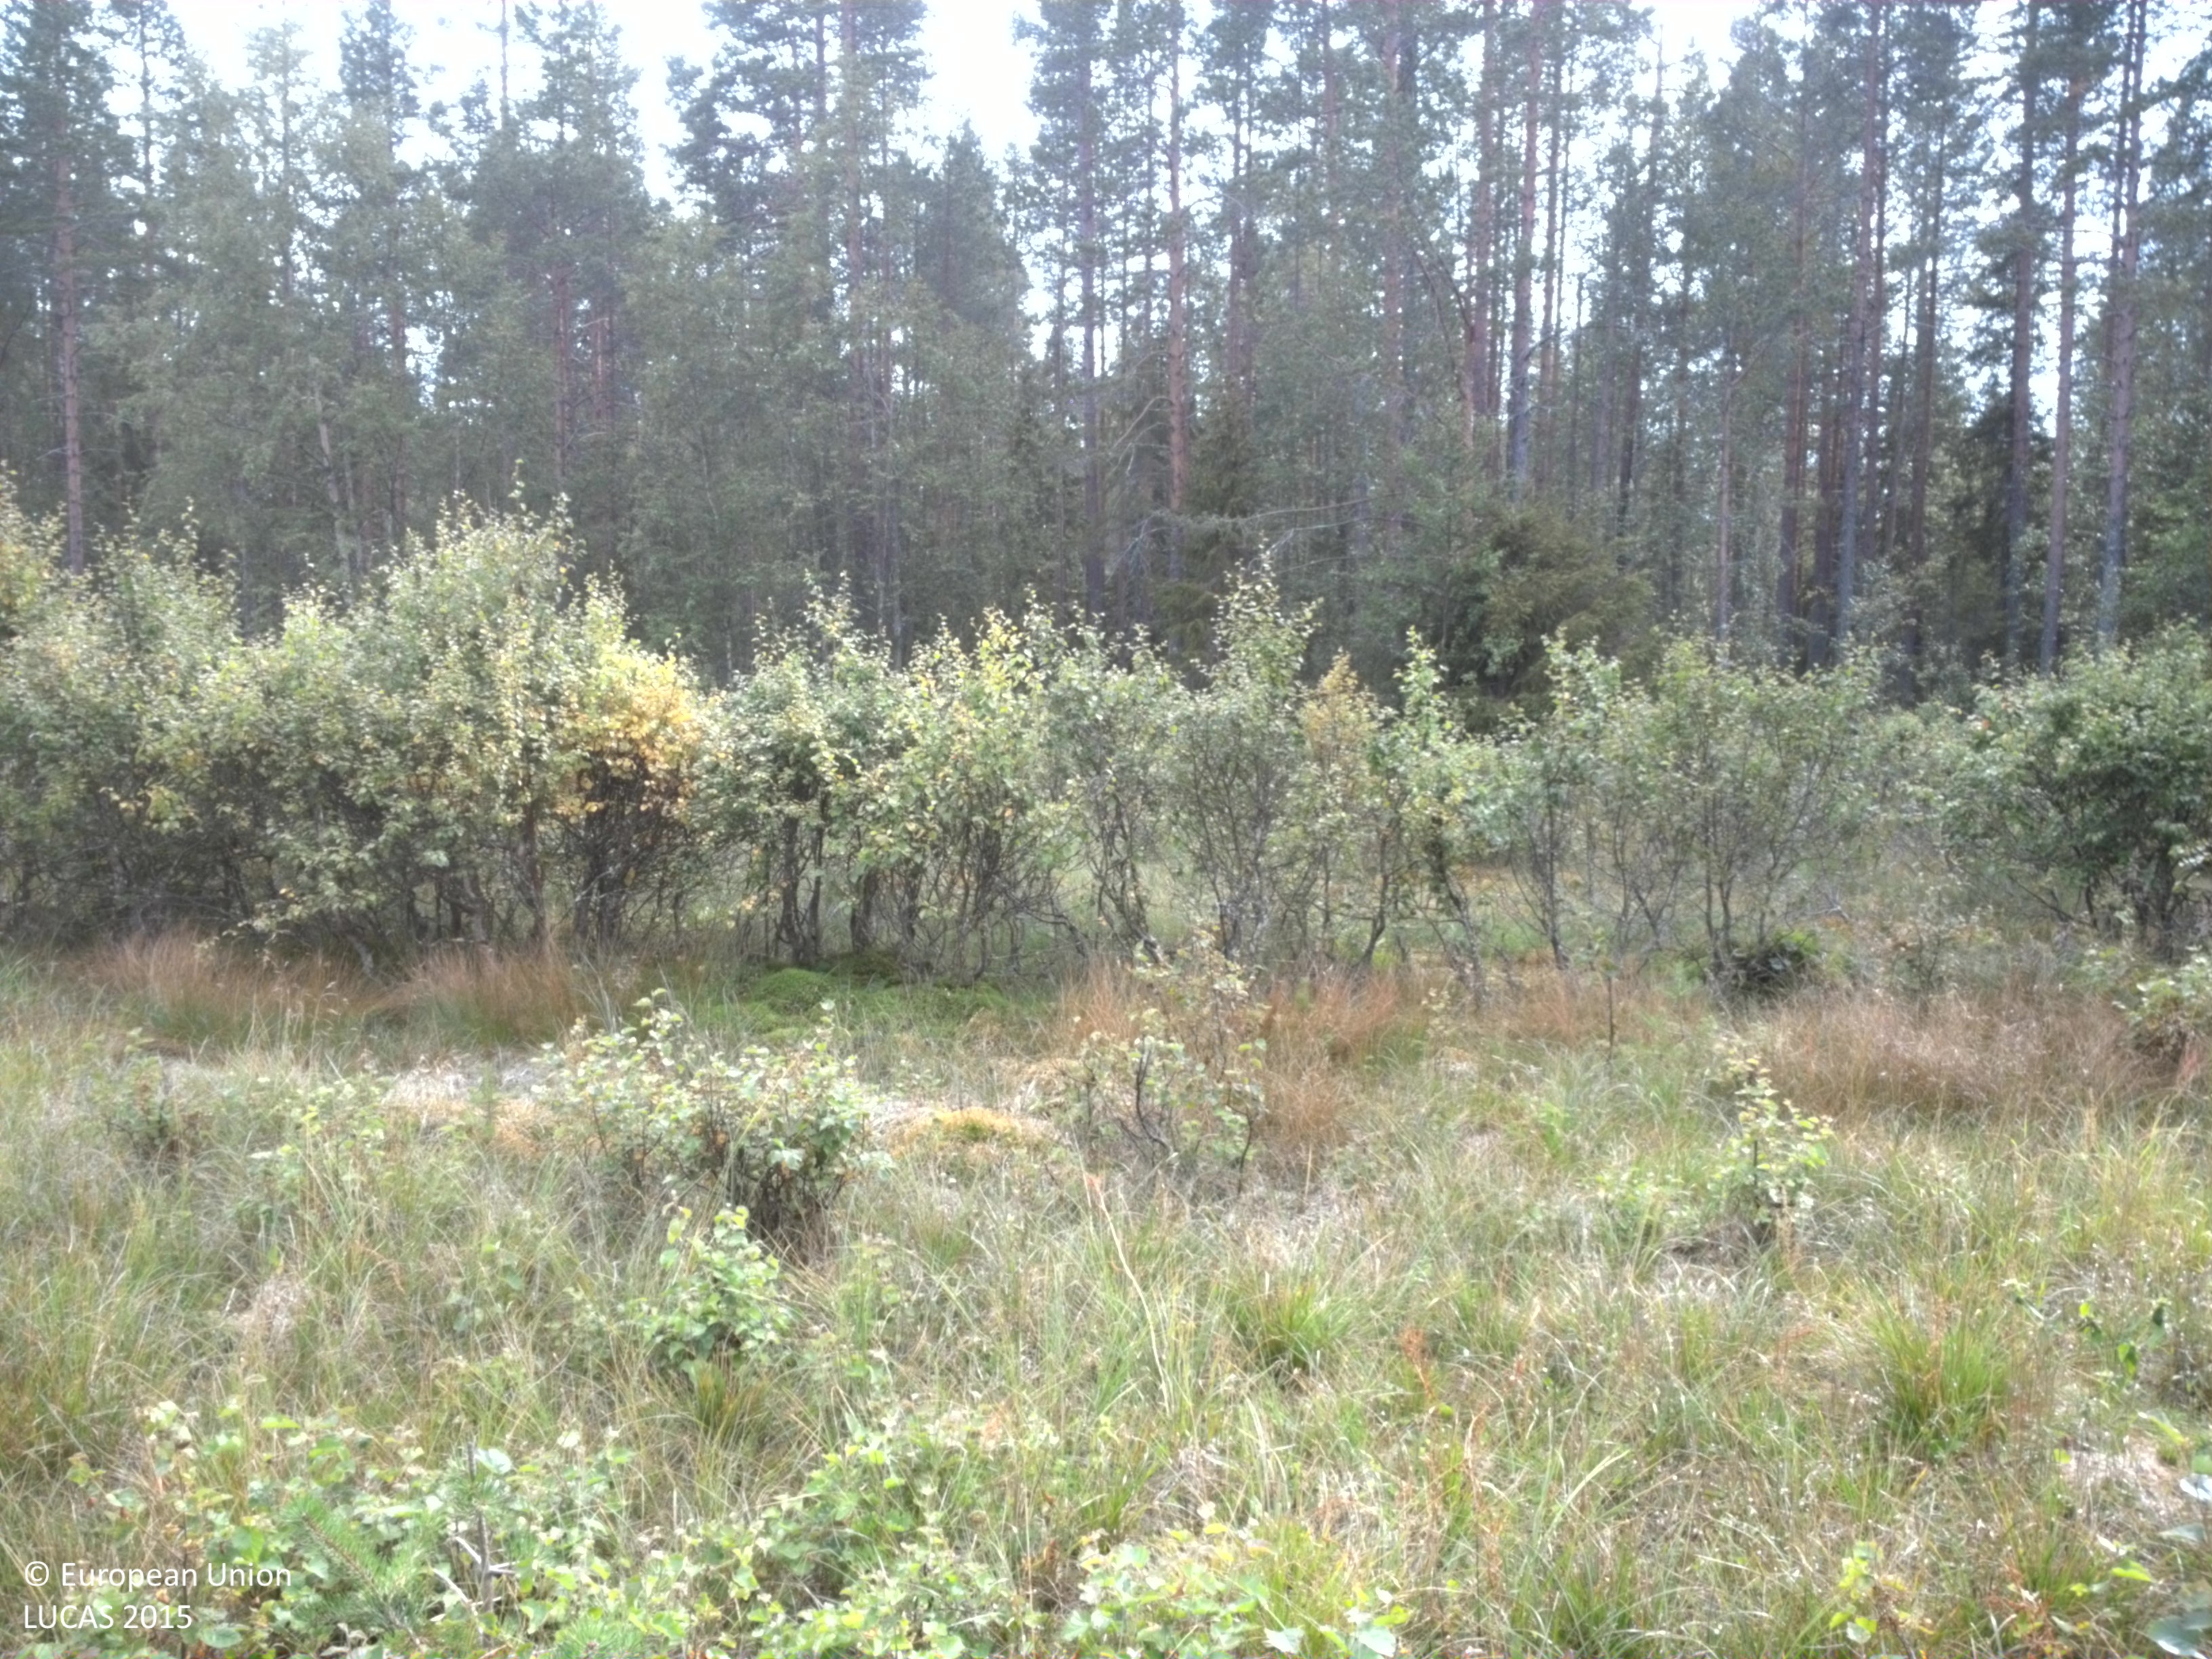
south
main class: Grassland
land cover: Grassland with sparse tree/shrub cover
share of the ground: > 75 %
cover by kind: herbaceous plants 90 %, broadleaved forest trees 5 %, shrubs 5 %
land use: Semi-natural and natural areas not in use
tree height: < 5 m
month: August
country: SE
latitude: 64.5041
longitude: 20.2405
